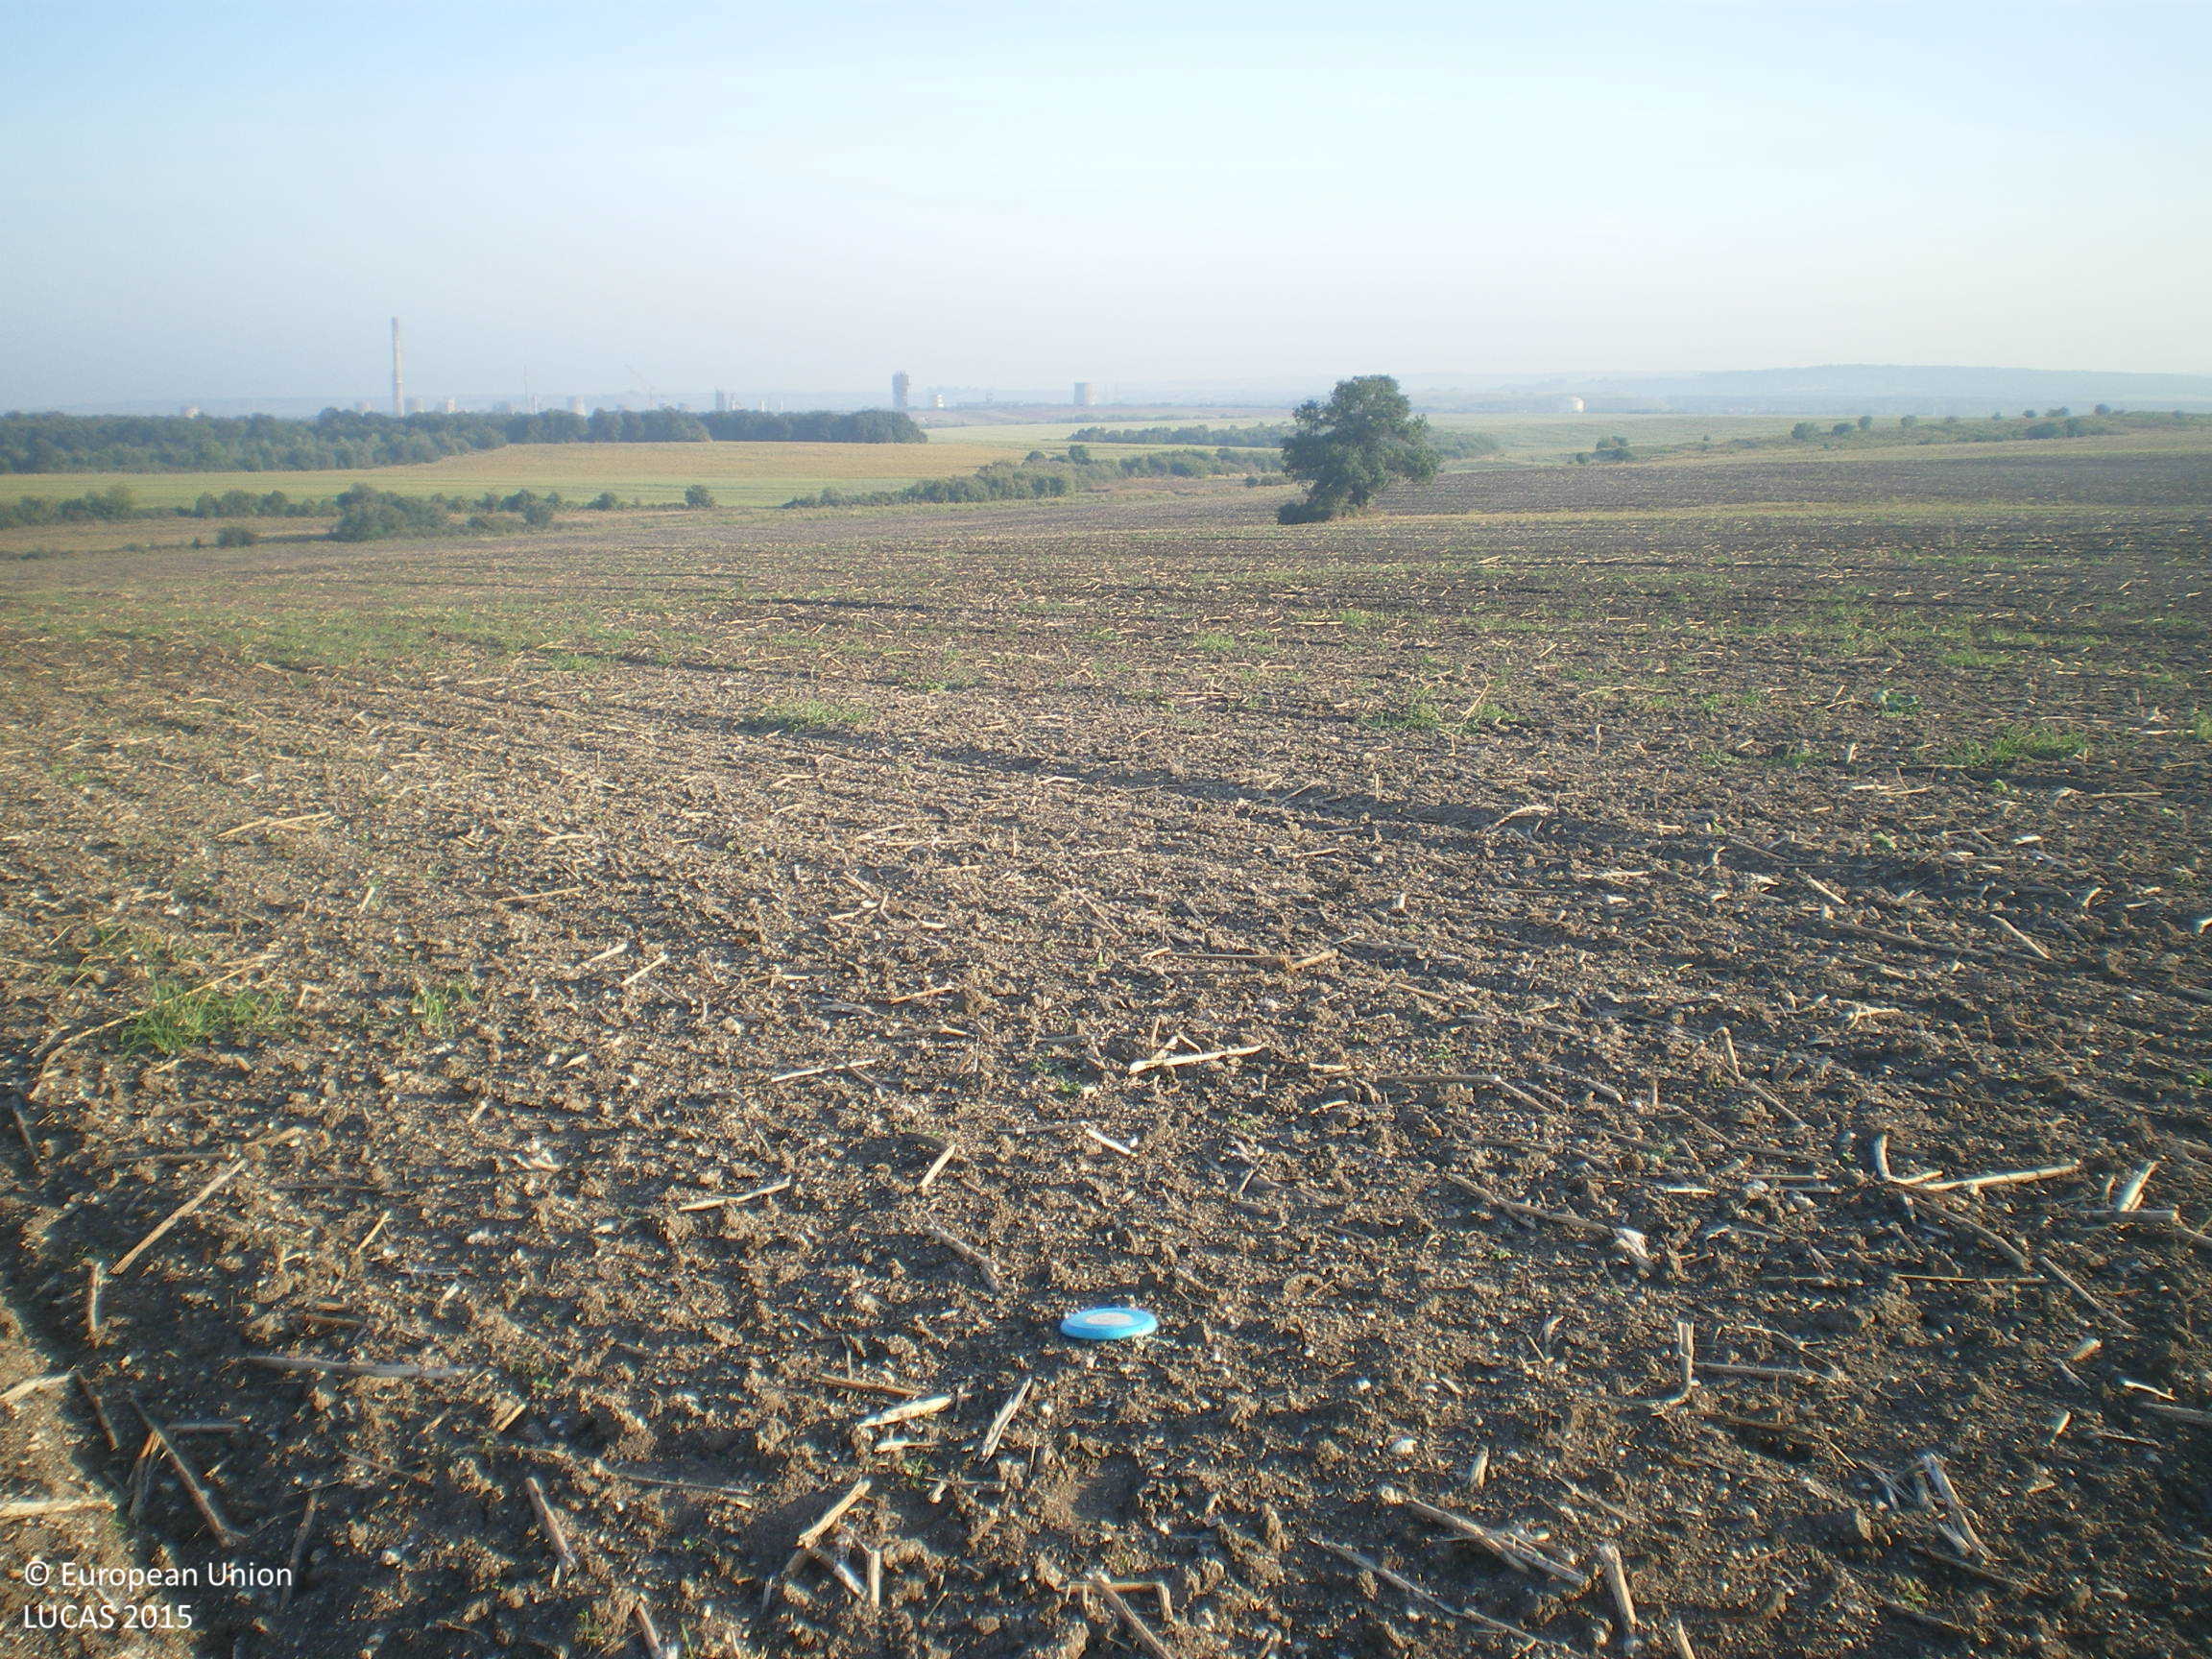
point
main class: Cropland
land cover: Sunflower
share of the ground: < 10 %
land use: Agriculture (excluding fallow land and kitchen gardens)
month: September
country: BG
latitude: 42.0189
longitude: 25.6334
